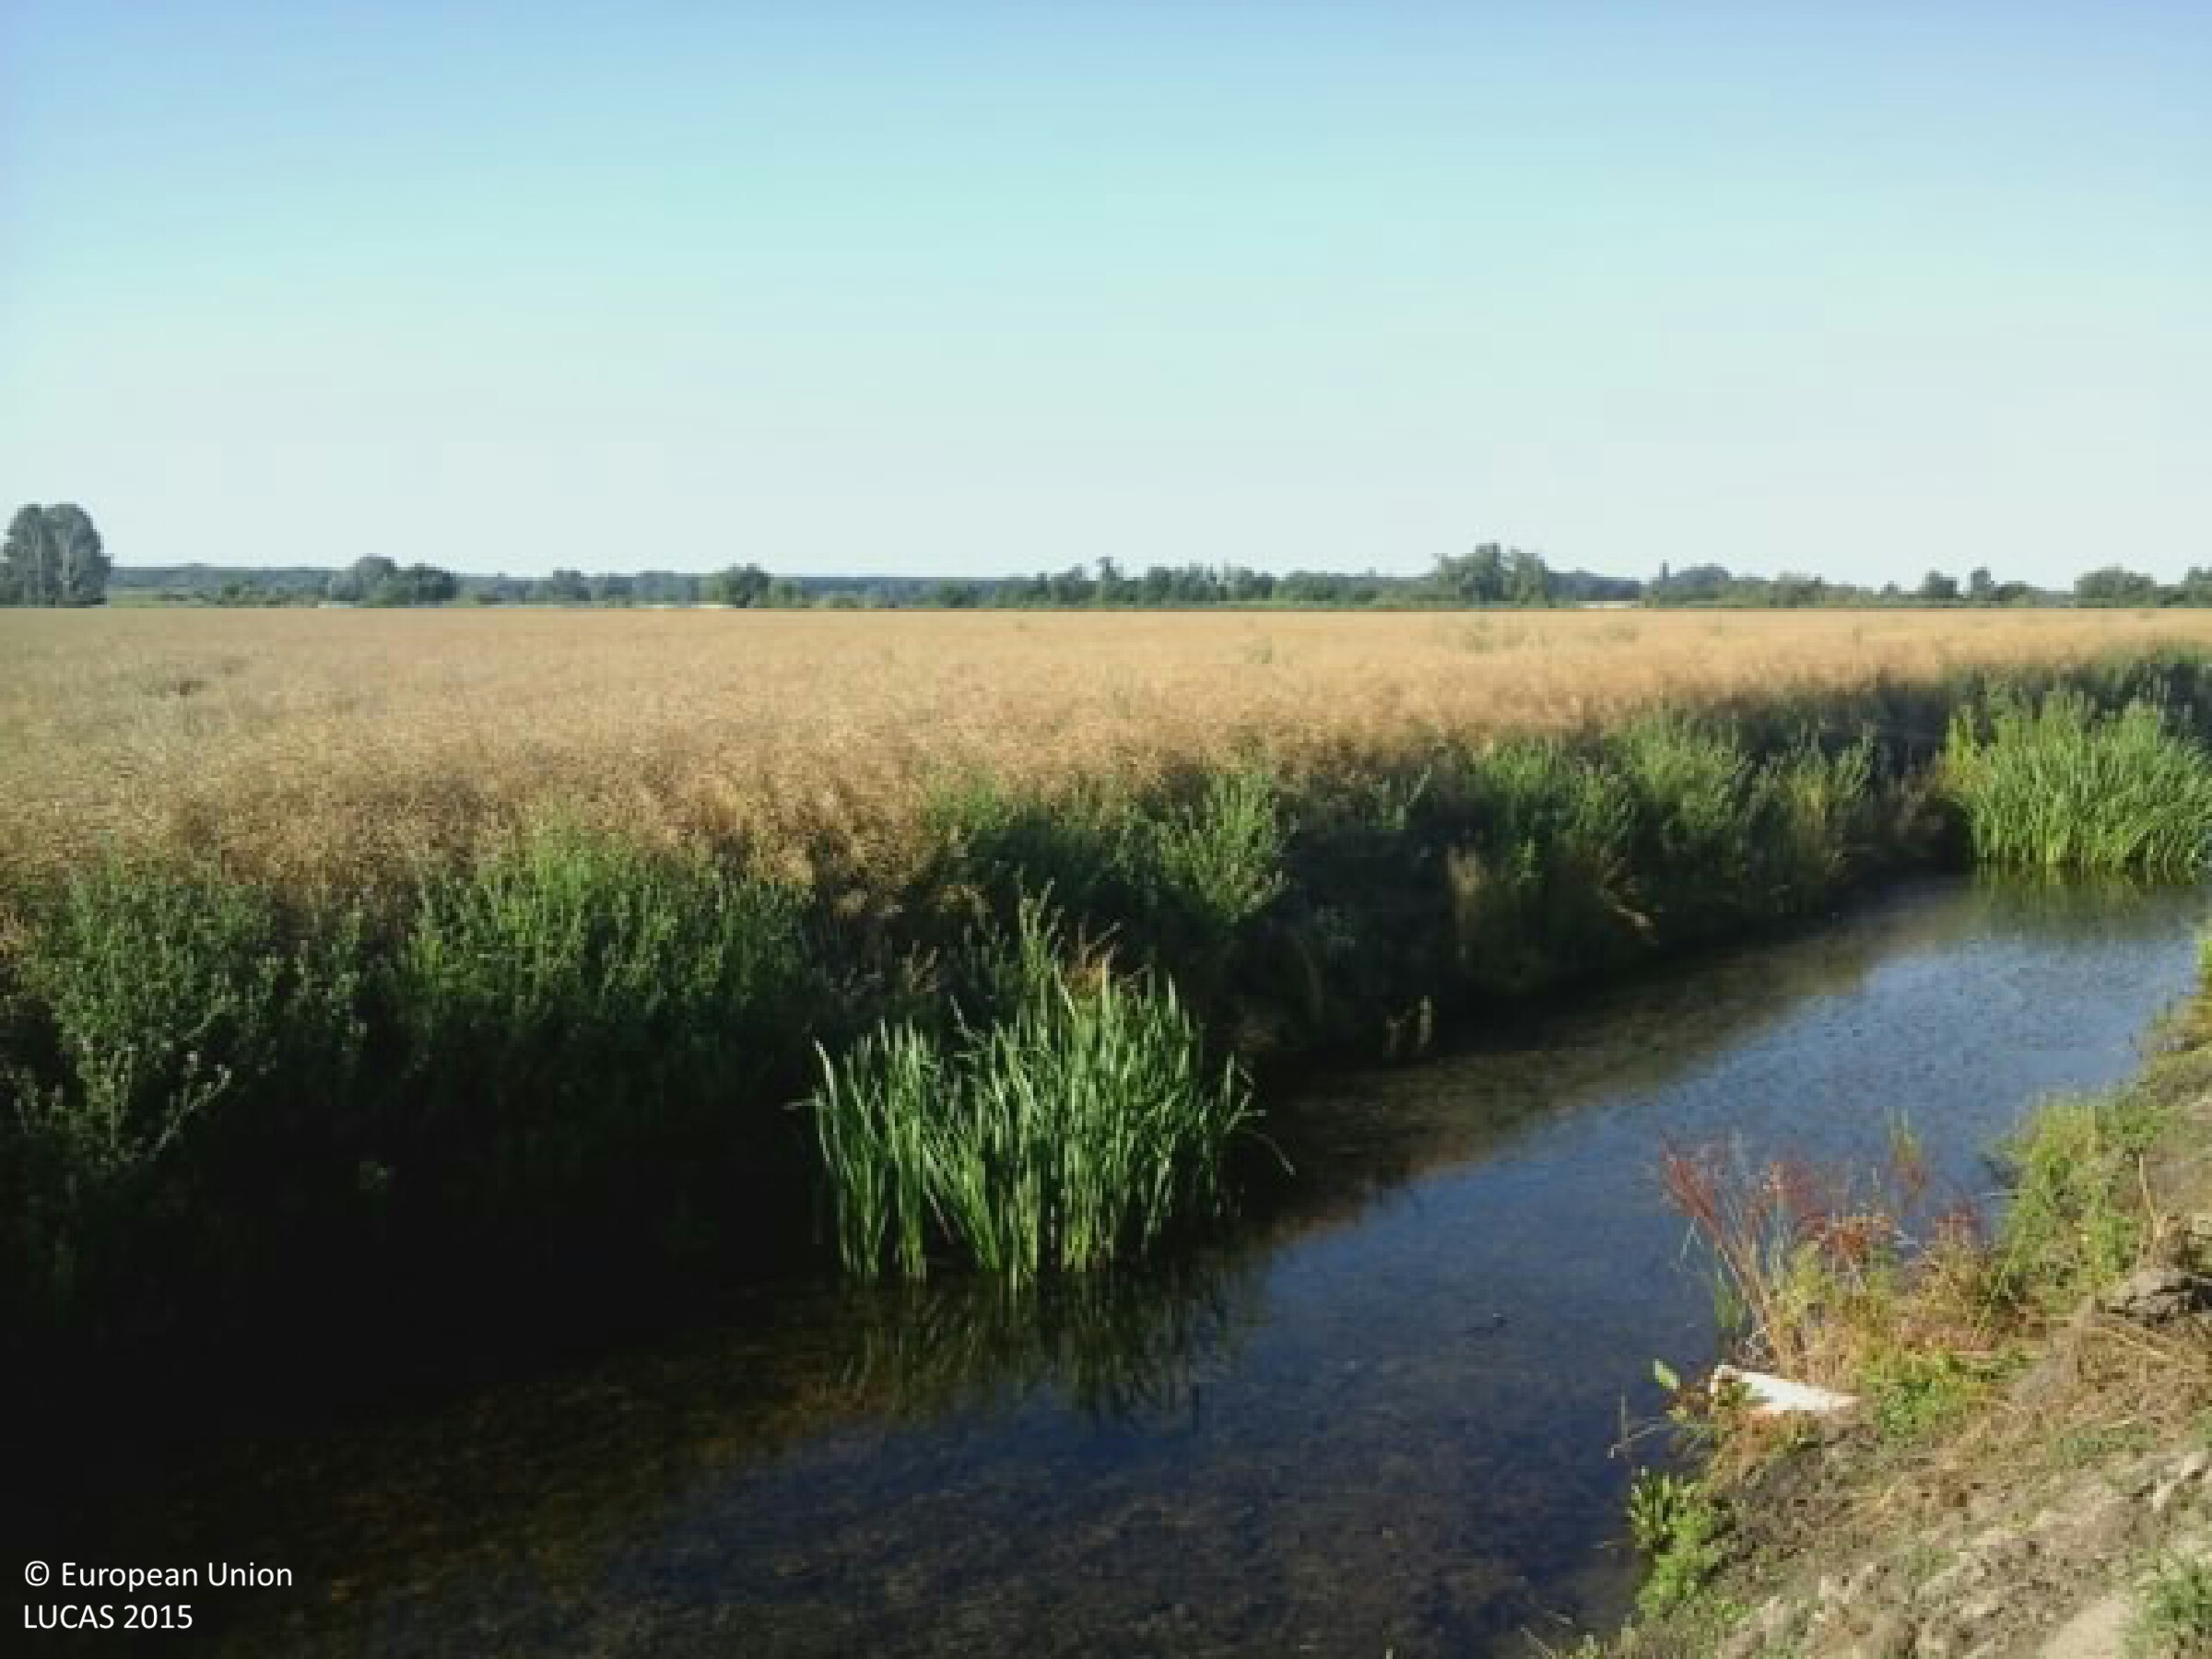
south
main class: Cropland
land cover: Rape and turnip rape
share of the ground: > 75 %
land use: Agriculture (excluding fallow land and kitchen gardens)
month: July
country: HU
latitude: 46.3636
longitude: 19.0731
